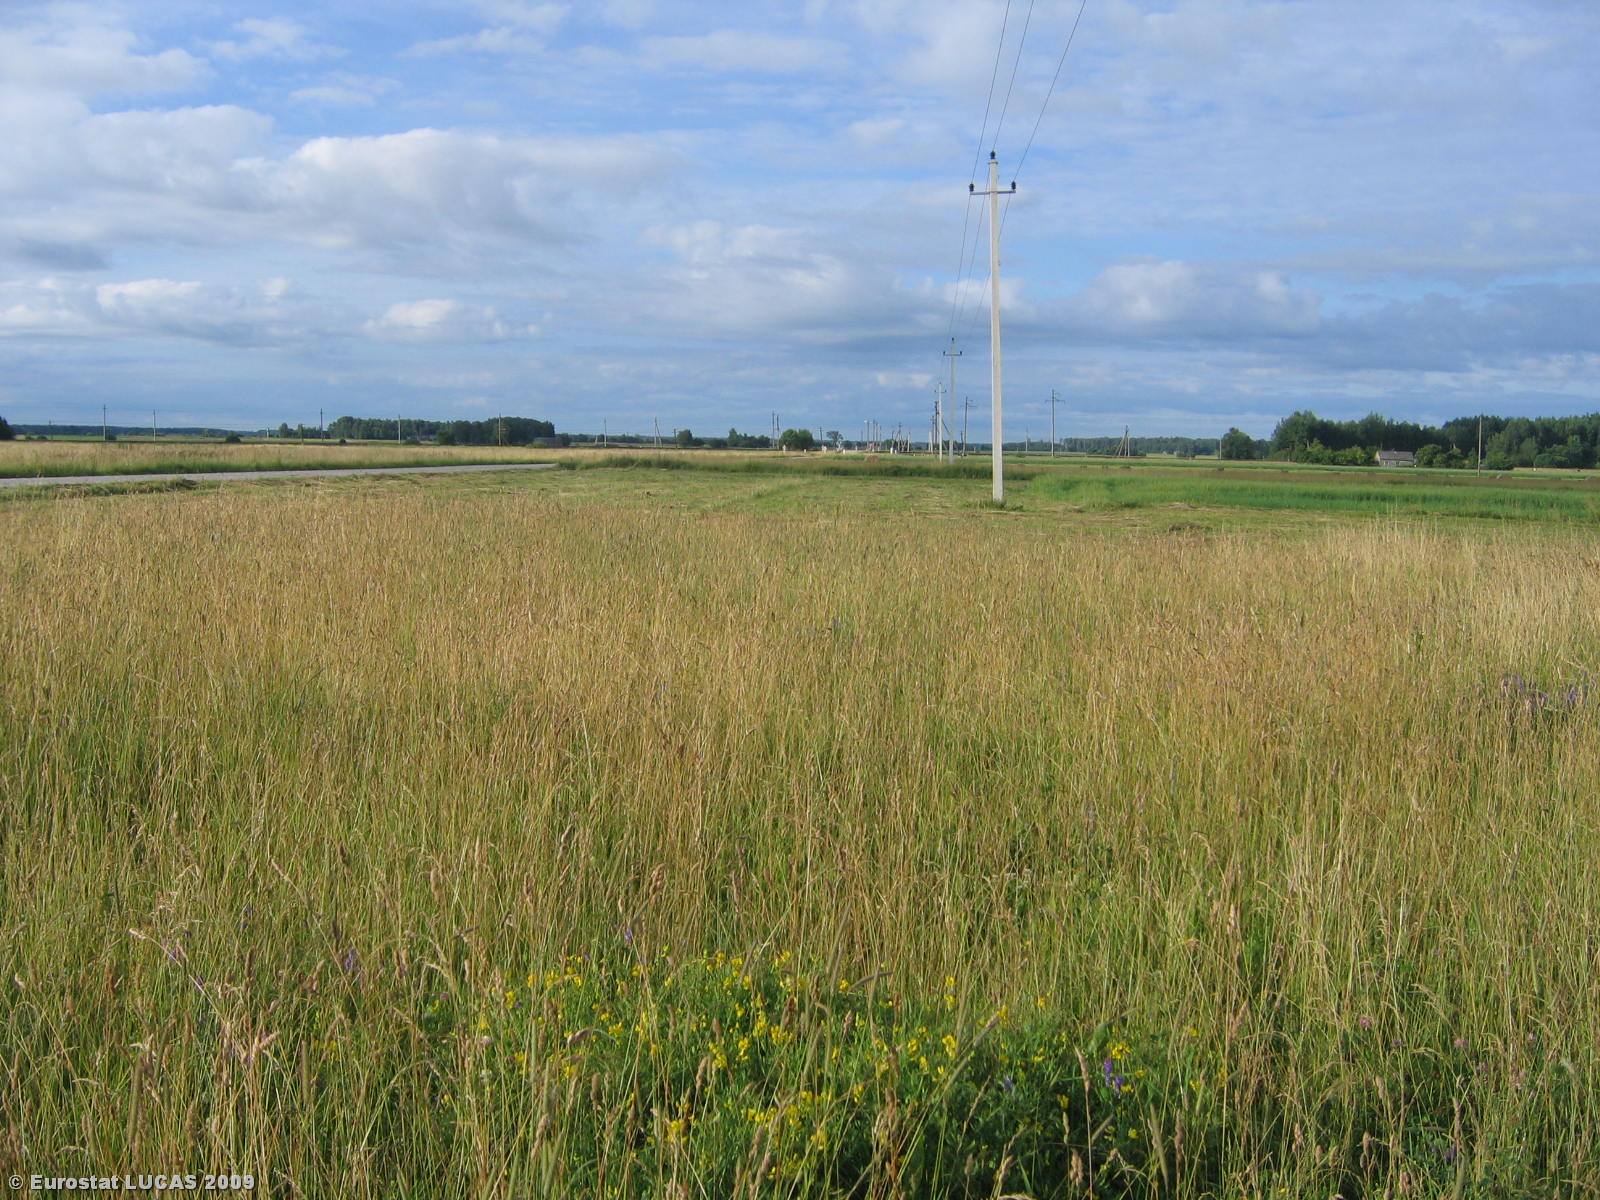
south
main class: Grassland
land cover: Grassland without tree/shrub cover
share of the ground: > 75 %
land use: Agriculture (excluding fallow land and kitchen gardens)
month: July
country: LT
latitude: 55.3677
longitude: 22.7350
